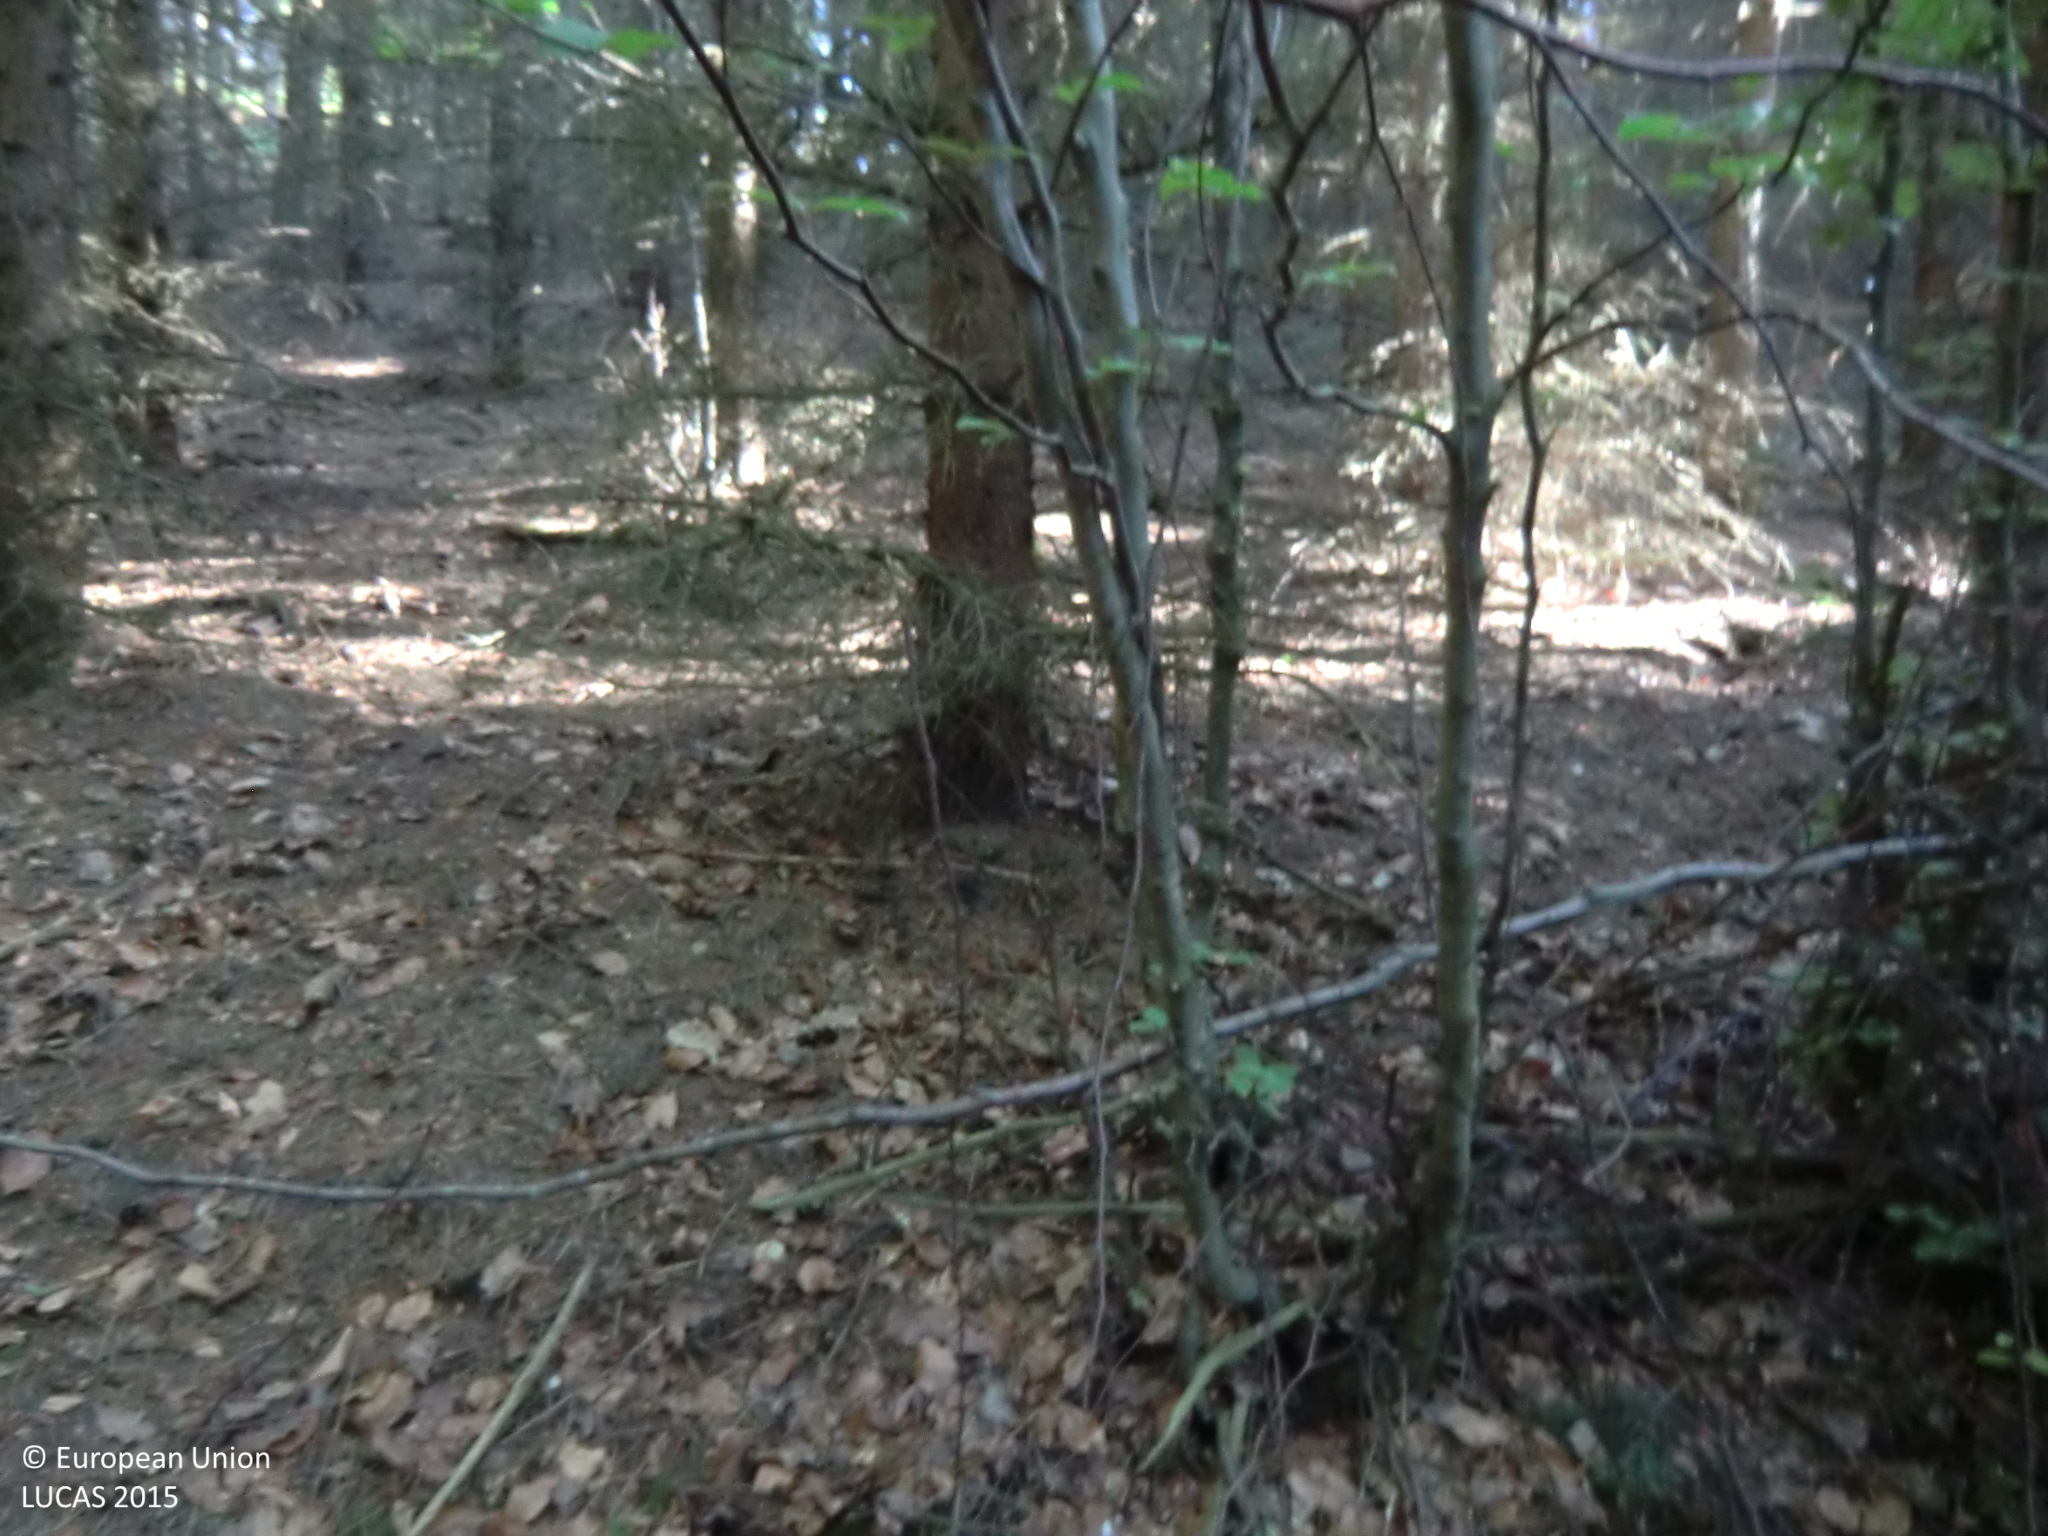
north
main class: Woodland
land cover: Spruce dominated coniferous woodland
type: alpine coniferous forest
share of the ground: > 75 %
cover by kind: coniferous forest trees 90 %, broadleaved forest trees 5 %, consolidated bare surface 5 %
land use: Forestry
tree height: > 5 m
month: June
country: AT
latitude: 48.4592
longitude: 14.4225
